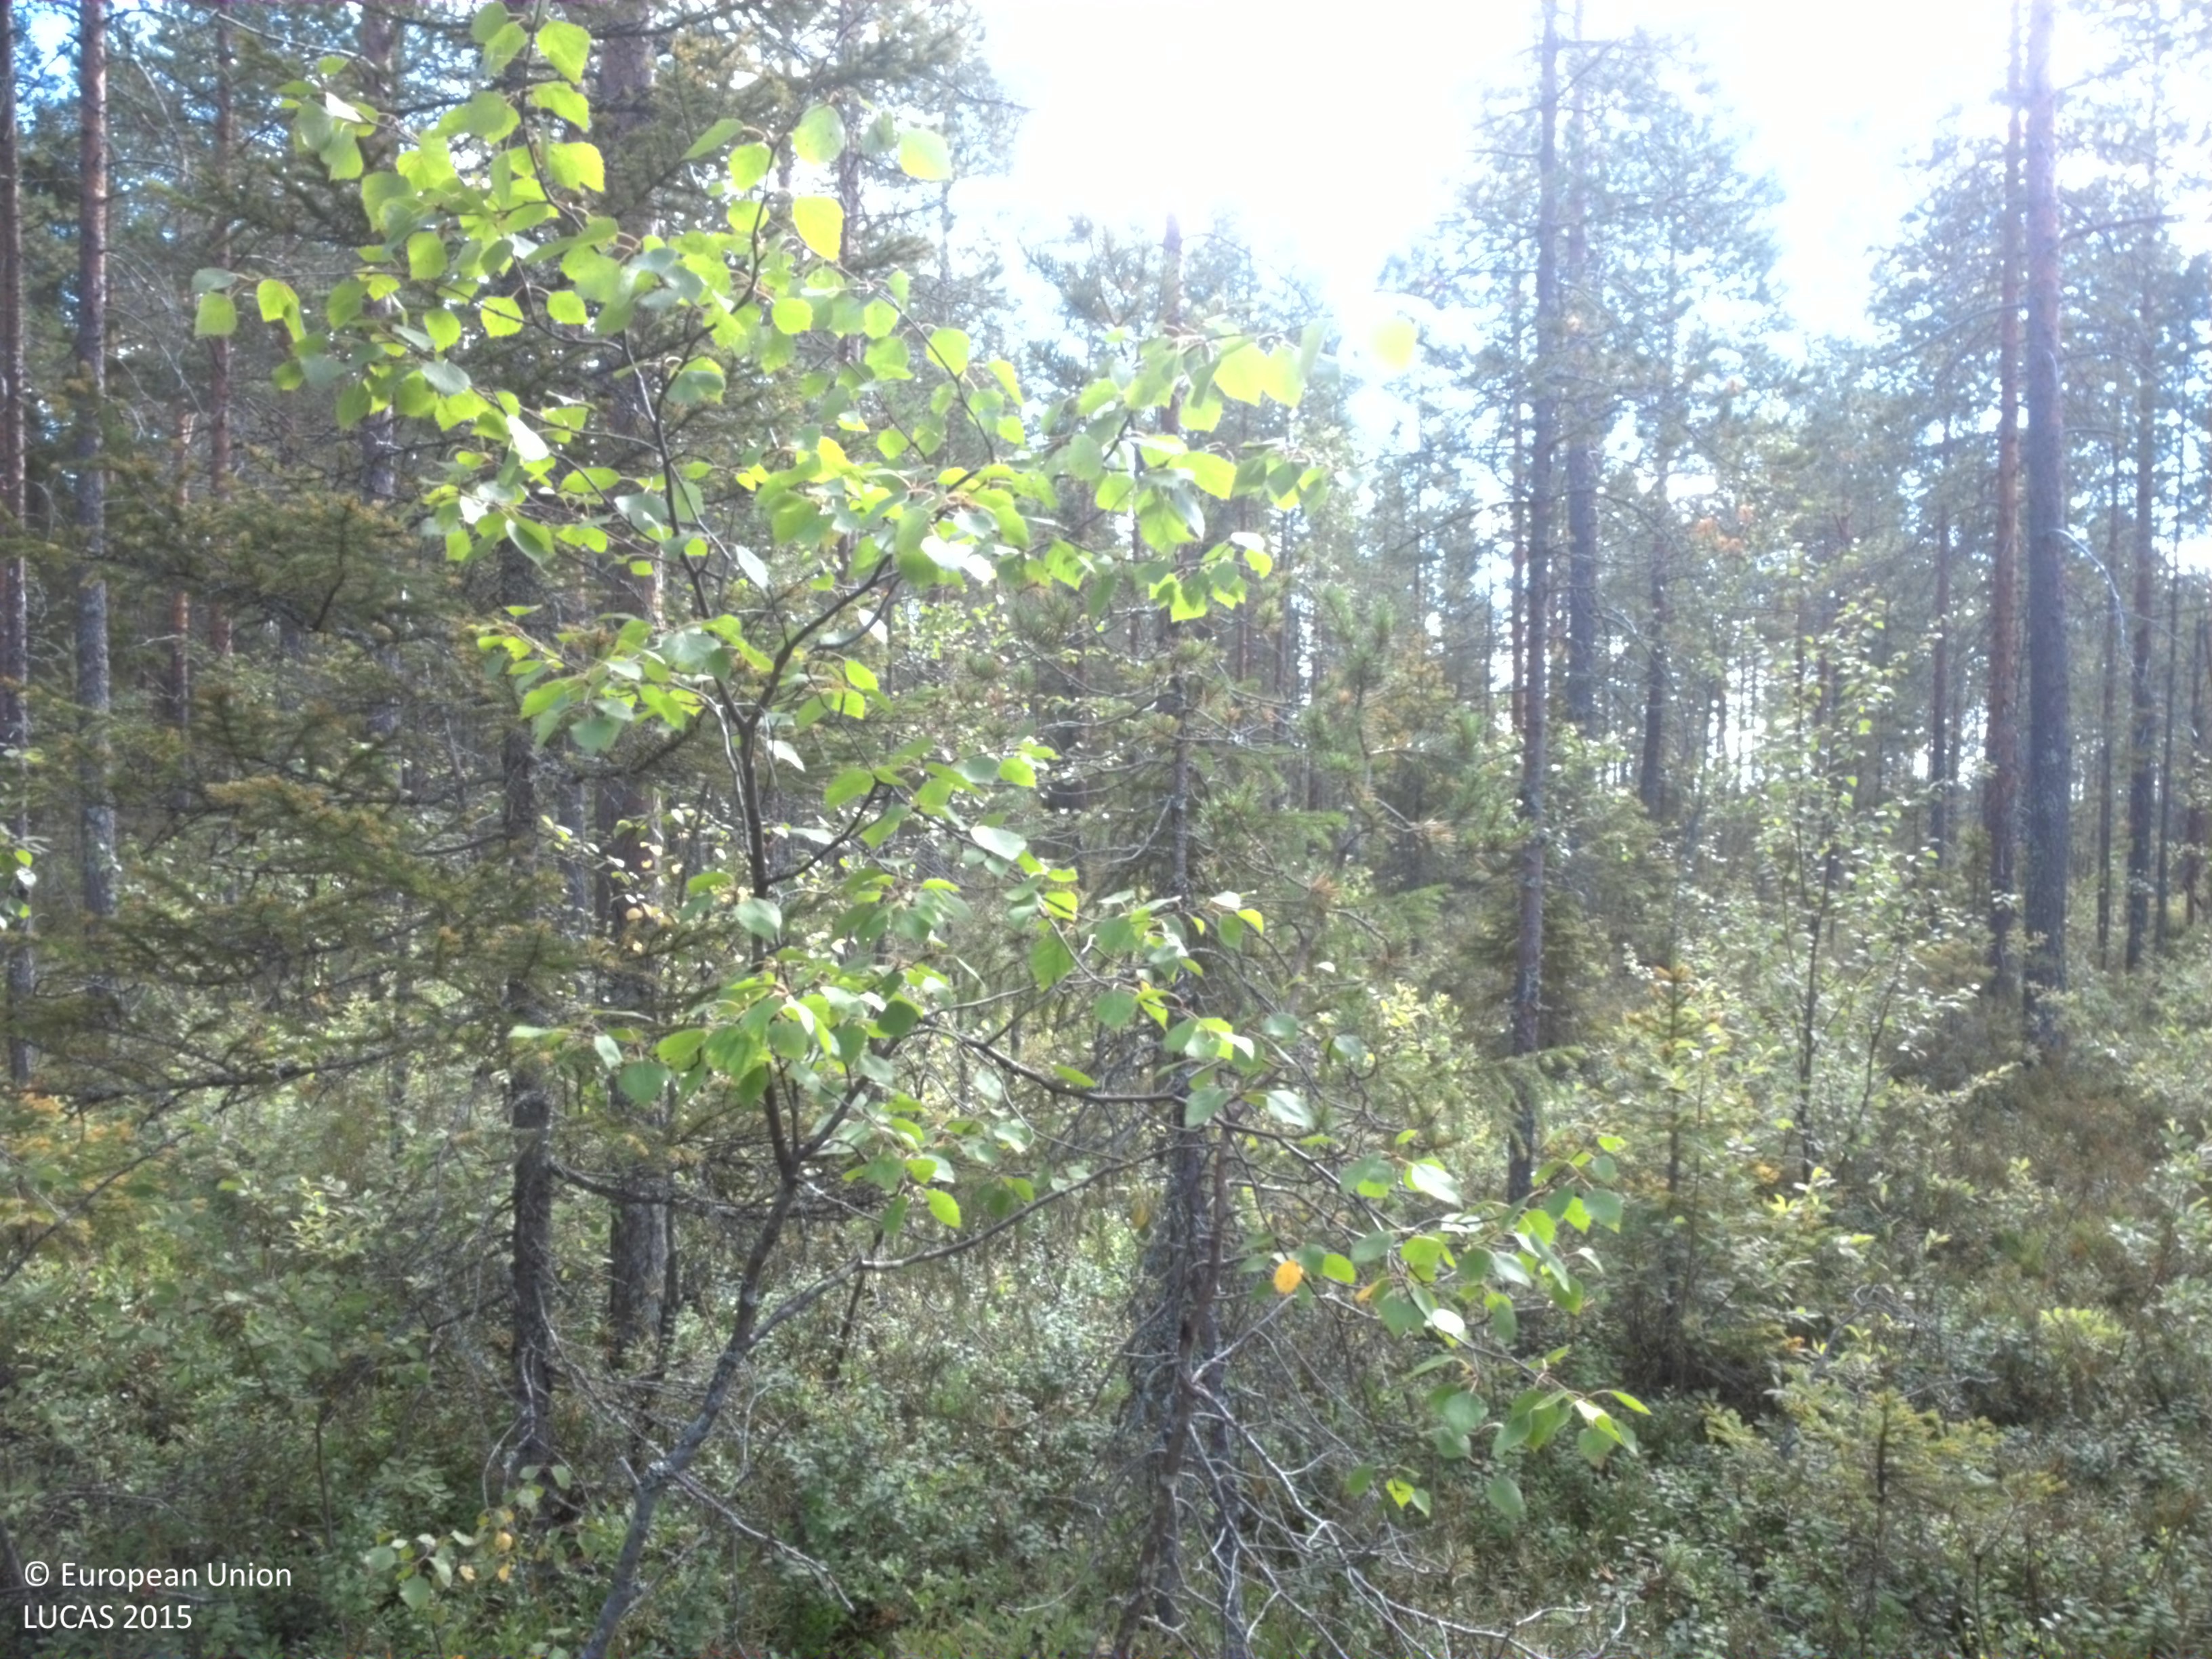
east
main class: Woodland
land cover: Pine dominated coniferous woodland
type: boreal forest
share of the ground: 50 - 75 %
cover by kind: coniferous forest trees 55 %, shrubs 20 %, lichens and mosses 20 %, broadleaved forest trees 5 %
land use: Forestry
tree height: > 5 m
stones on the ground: > 50 %
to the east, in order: Pine dominated coniferous woodland; Other coniferous woodland; Other mixed woodland; Broadleaved woodland
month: August
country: SE
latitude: 64.0553
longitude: 20.4083
